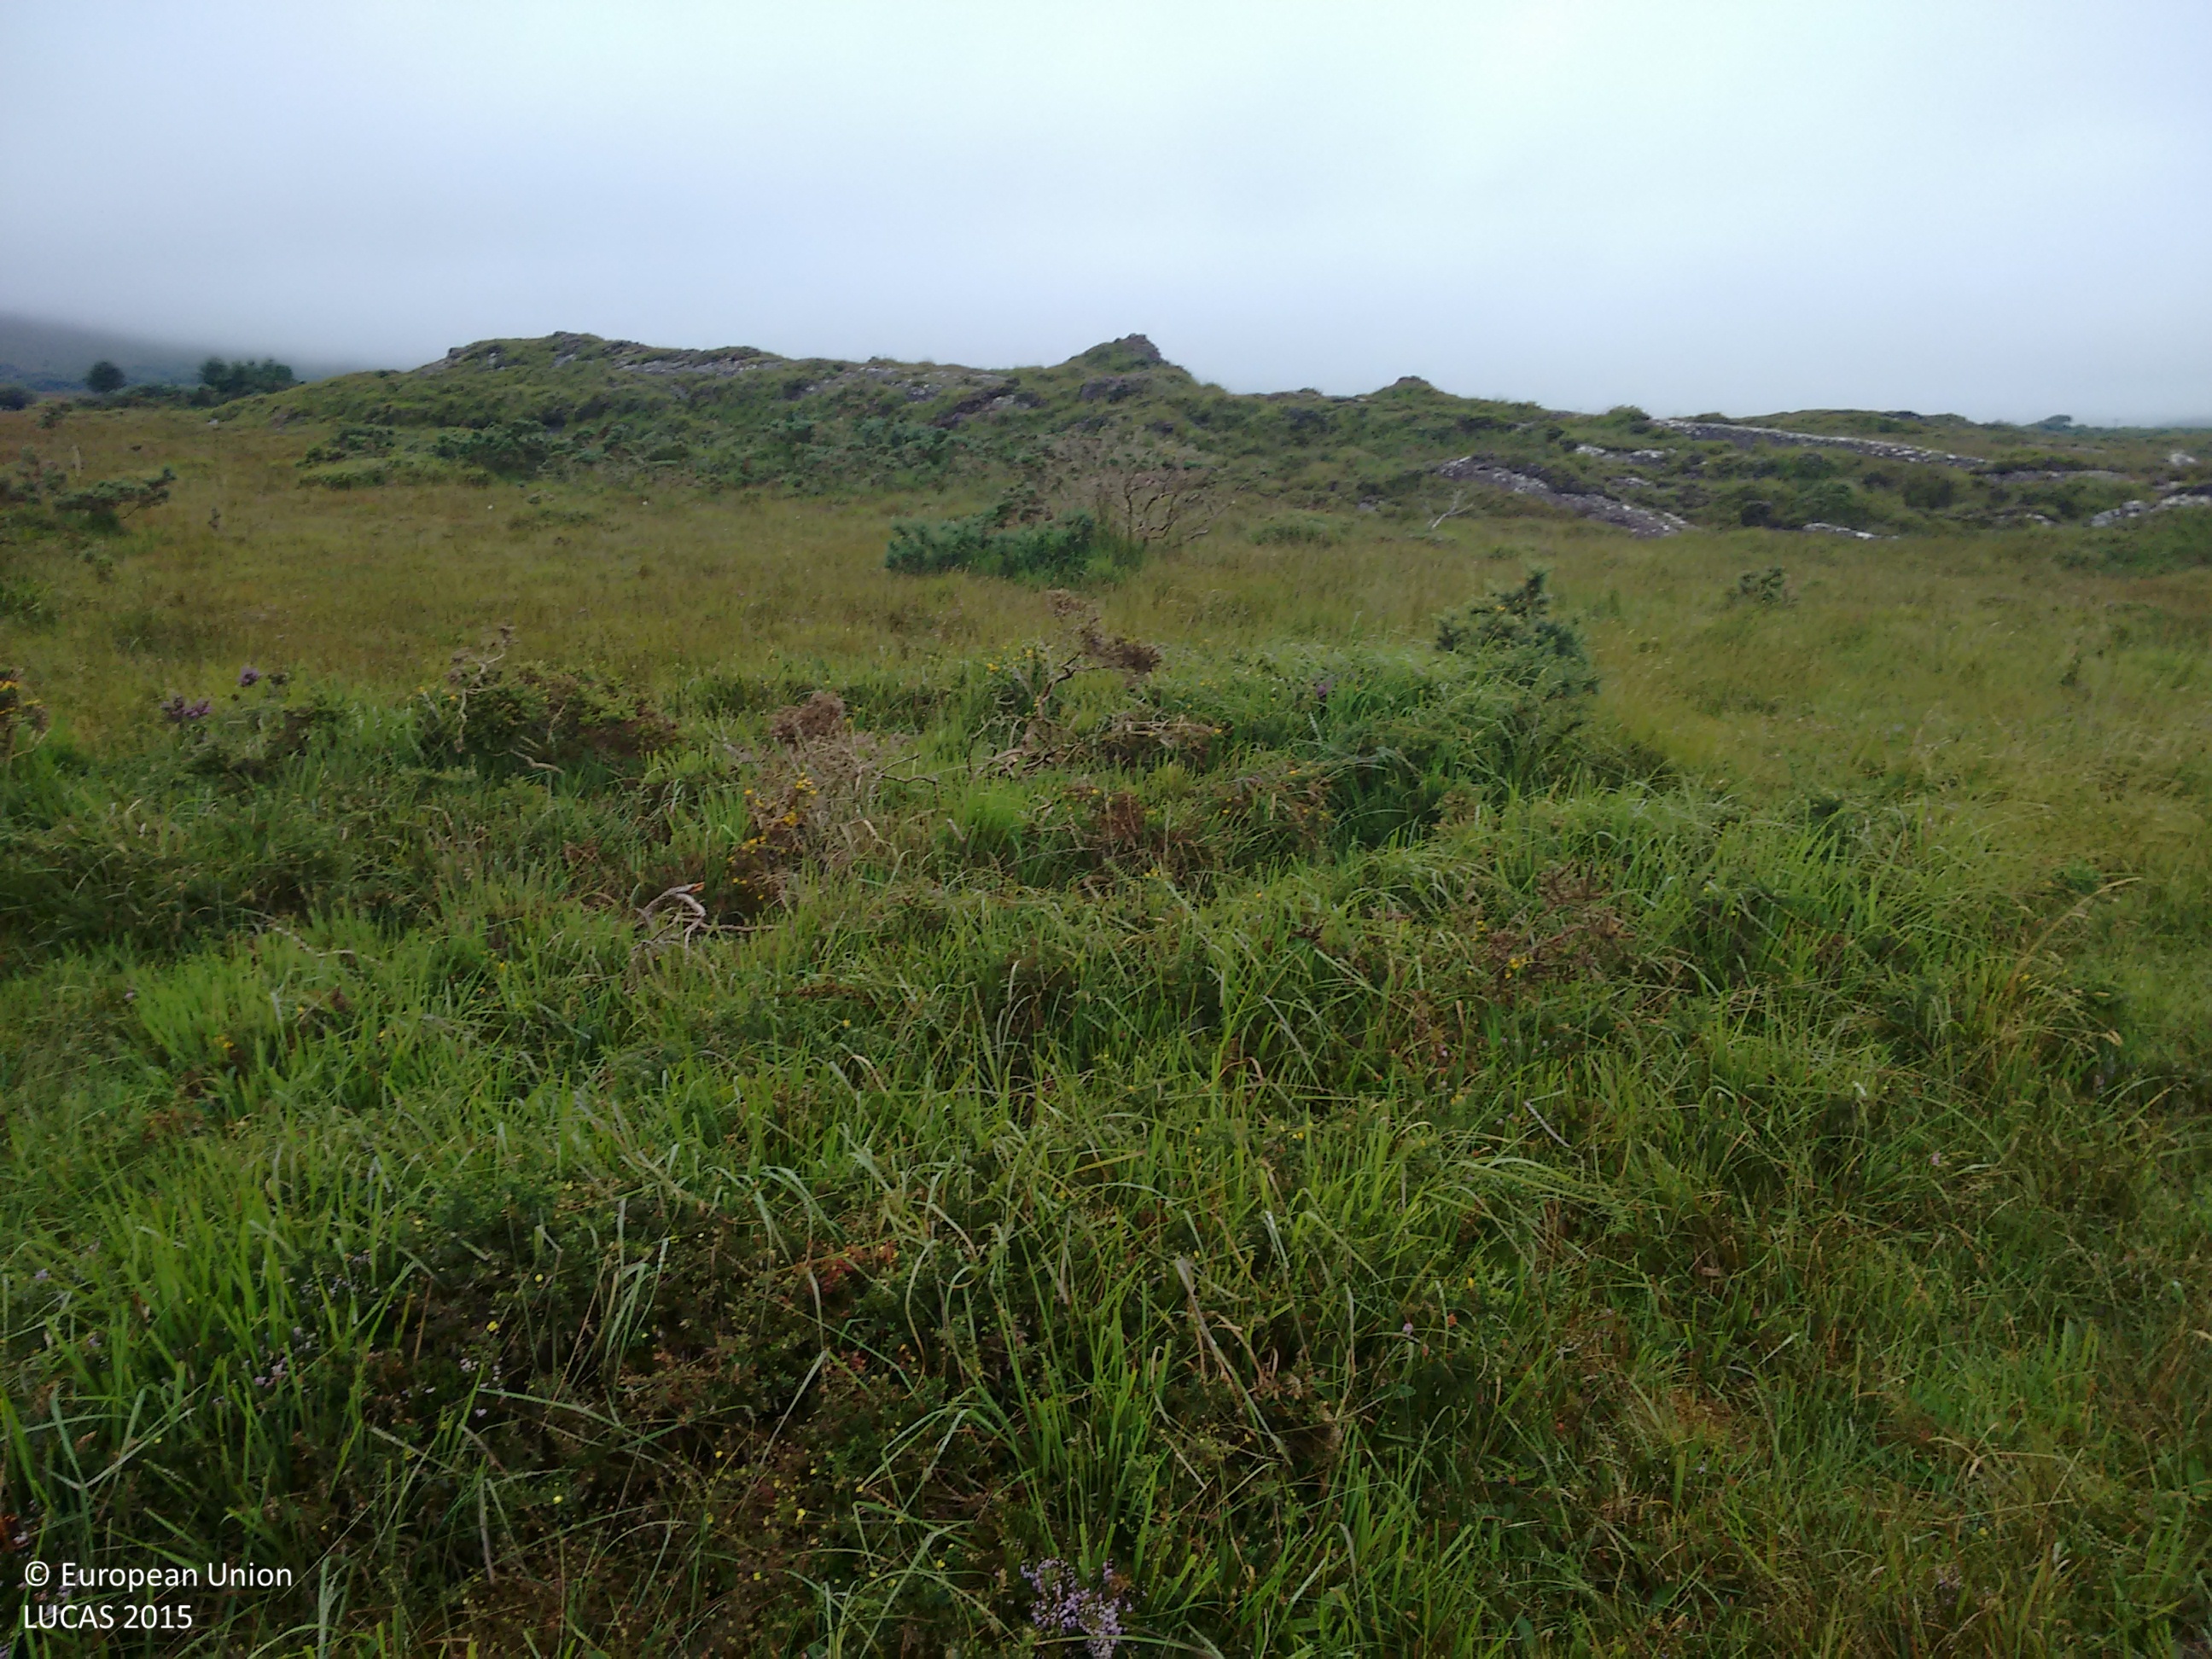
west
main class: Shrubland
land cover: Shrubland without tree cover
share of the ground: > 75 %
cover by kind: herbaceous plants 85 %, shrubs 15 %
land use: Agriculture (excluding fallow land and kitchen gardens)
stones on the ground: < 10 %
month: August
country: IE
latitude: 51.8330
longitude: -9.9136
